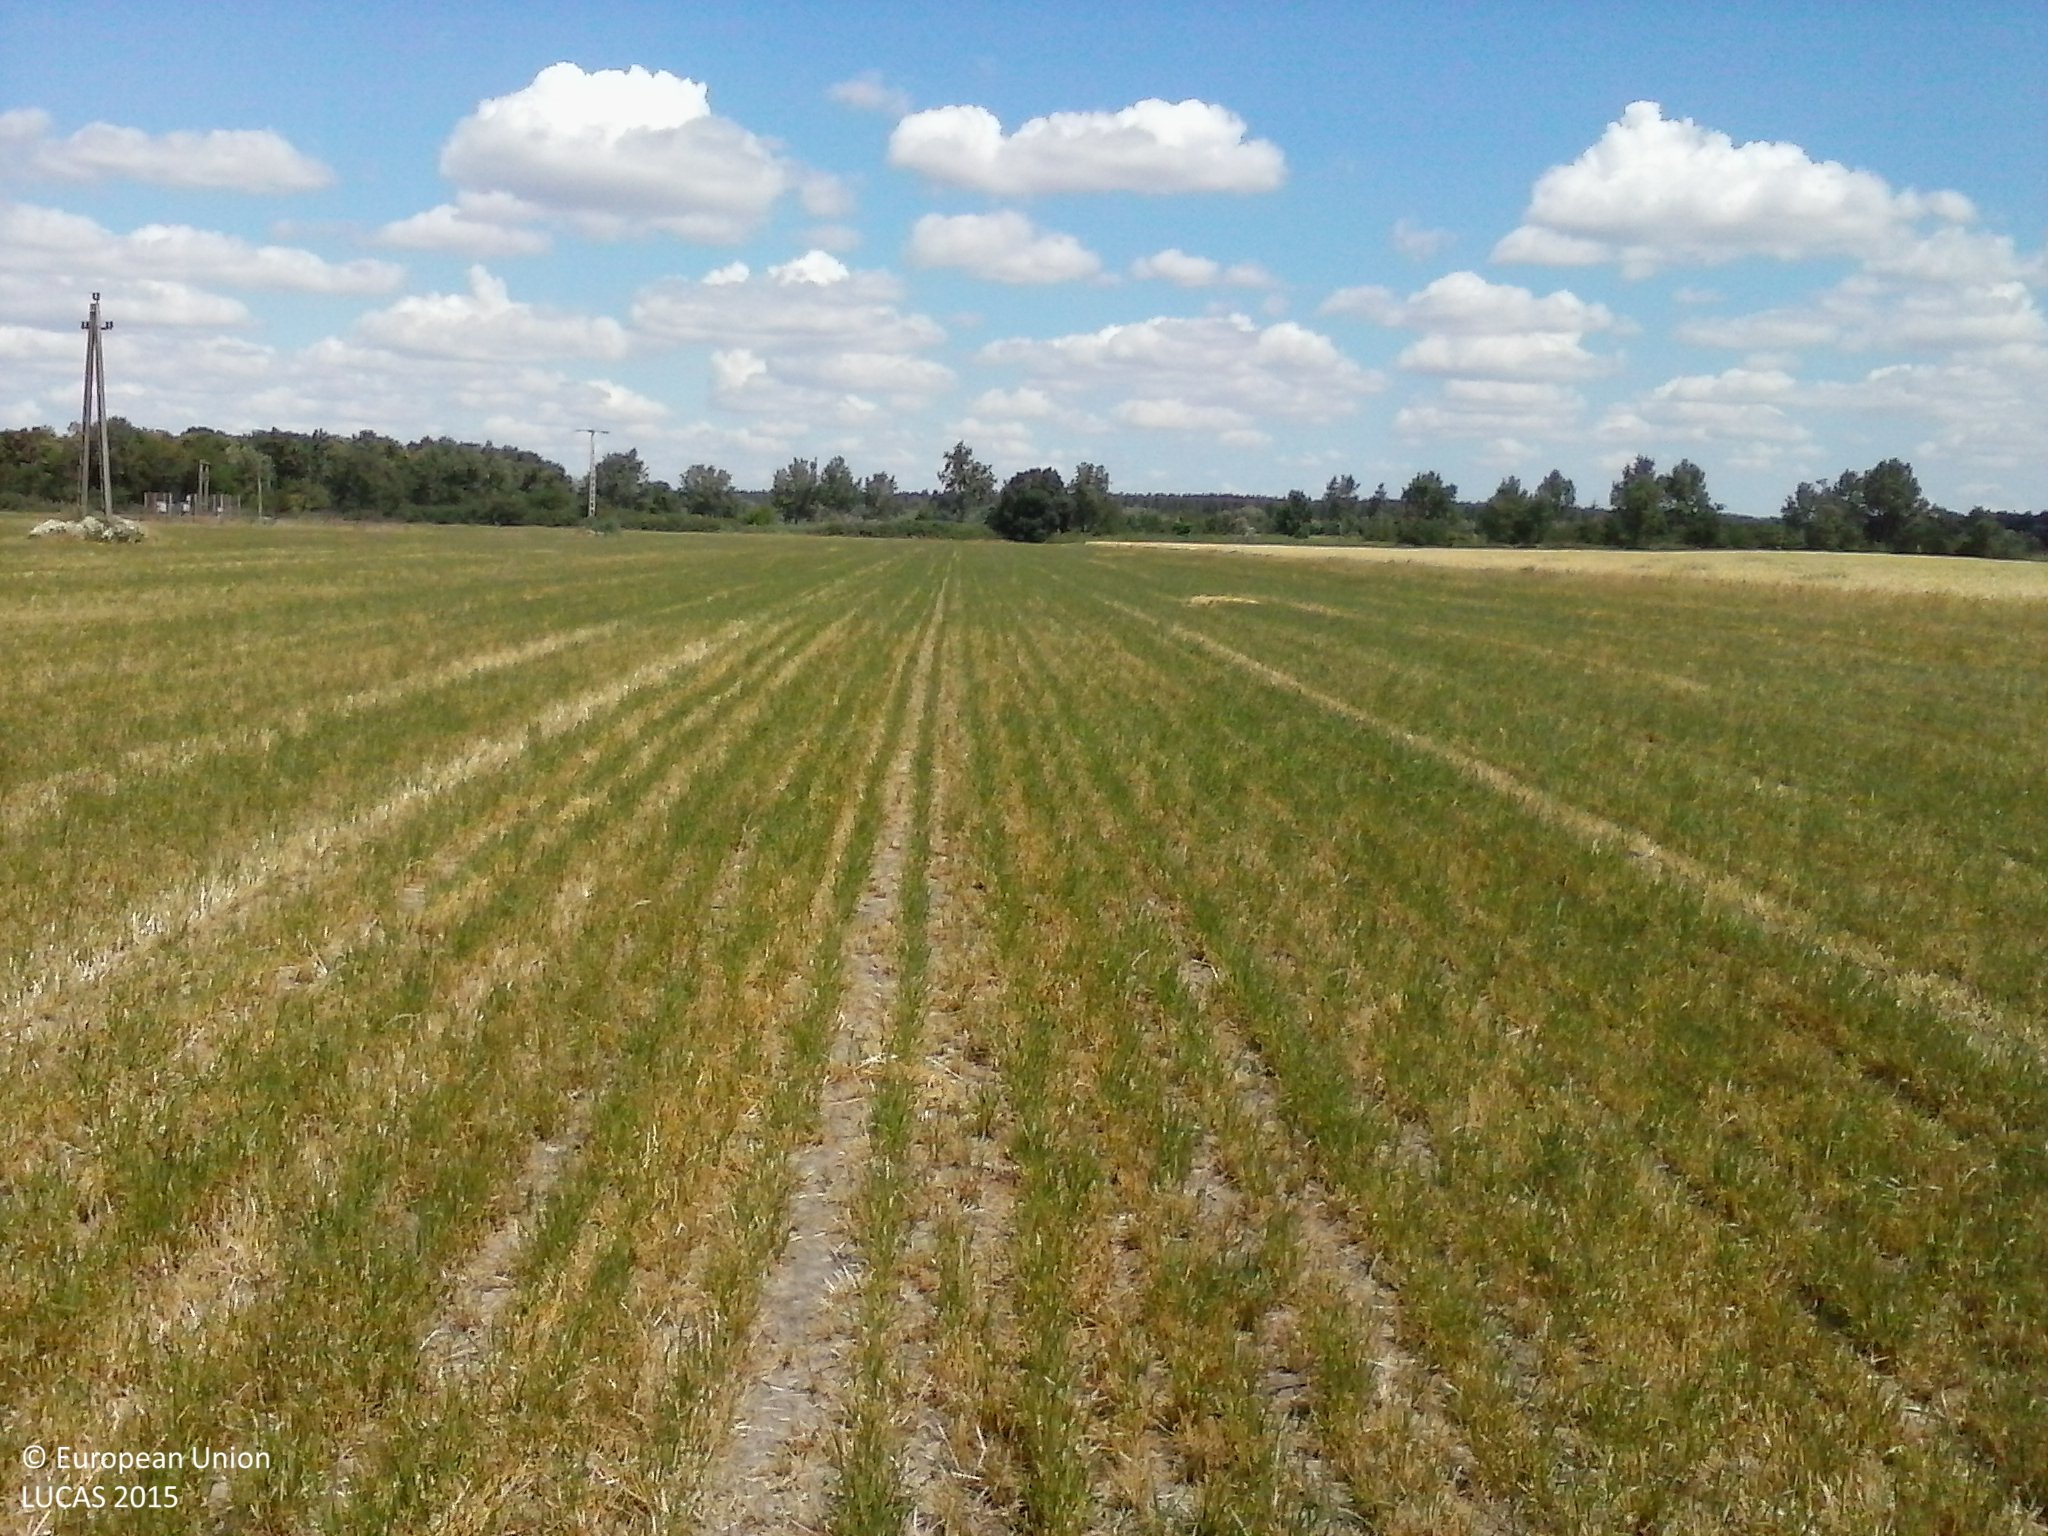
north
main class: Cropland
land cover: Common wheat
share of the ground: < 10 %
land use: Agriculture (excluding fallow land and kitchen gardens)
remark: Harvested field
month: June
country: HU
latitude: 46.2154
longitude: 20.3027
